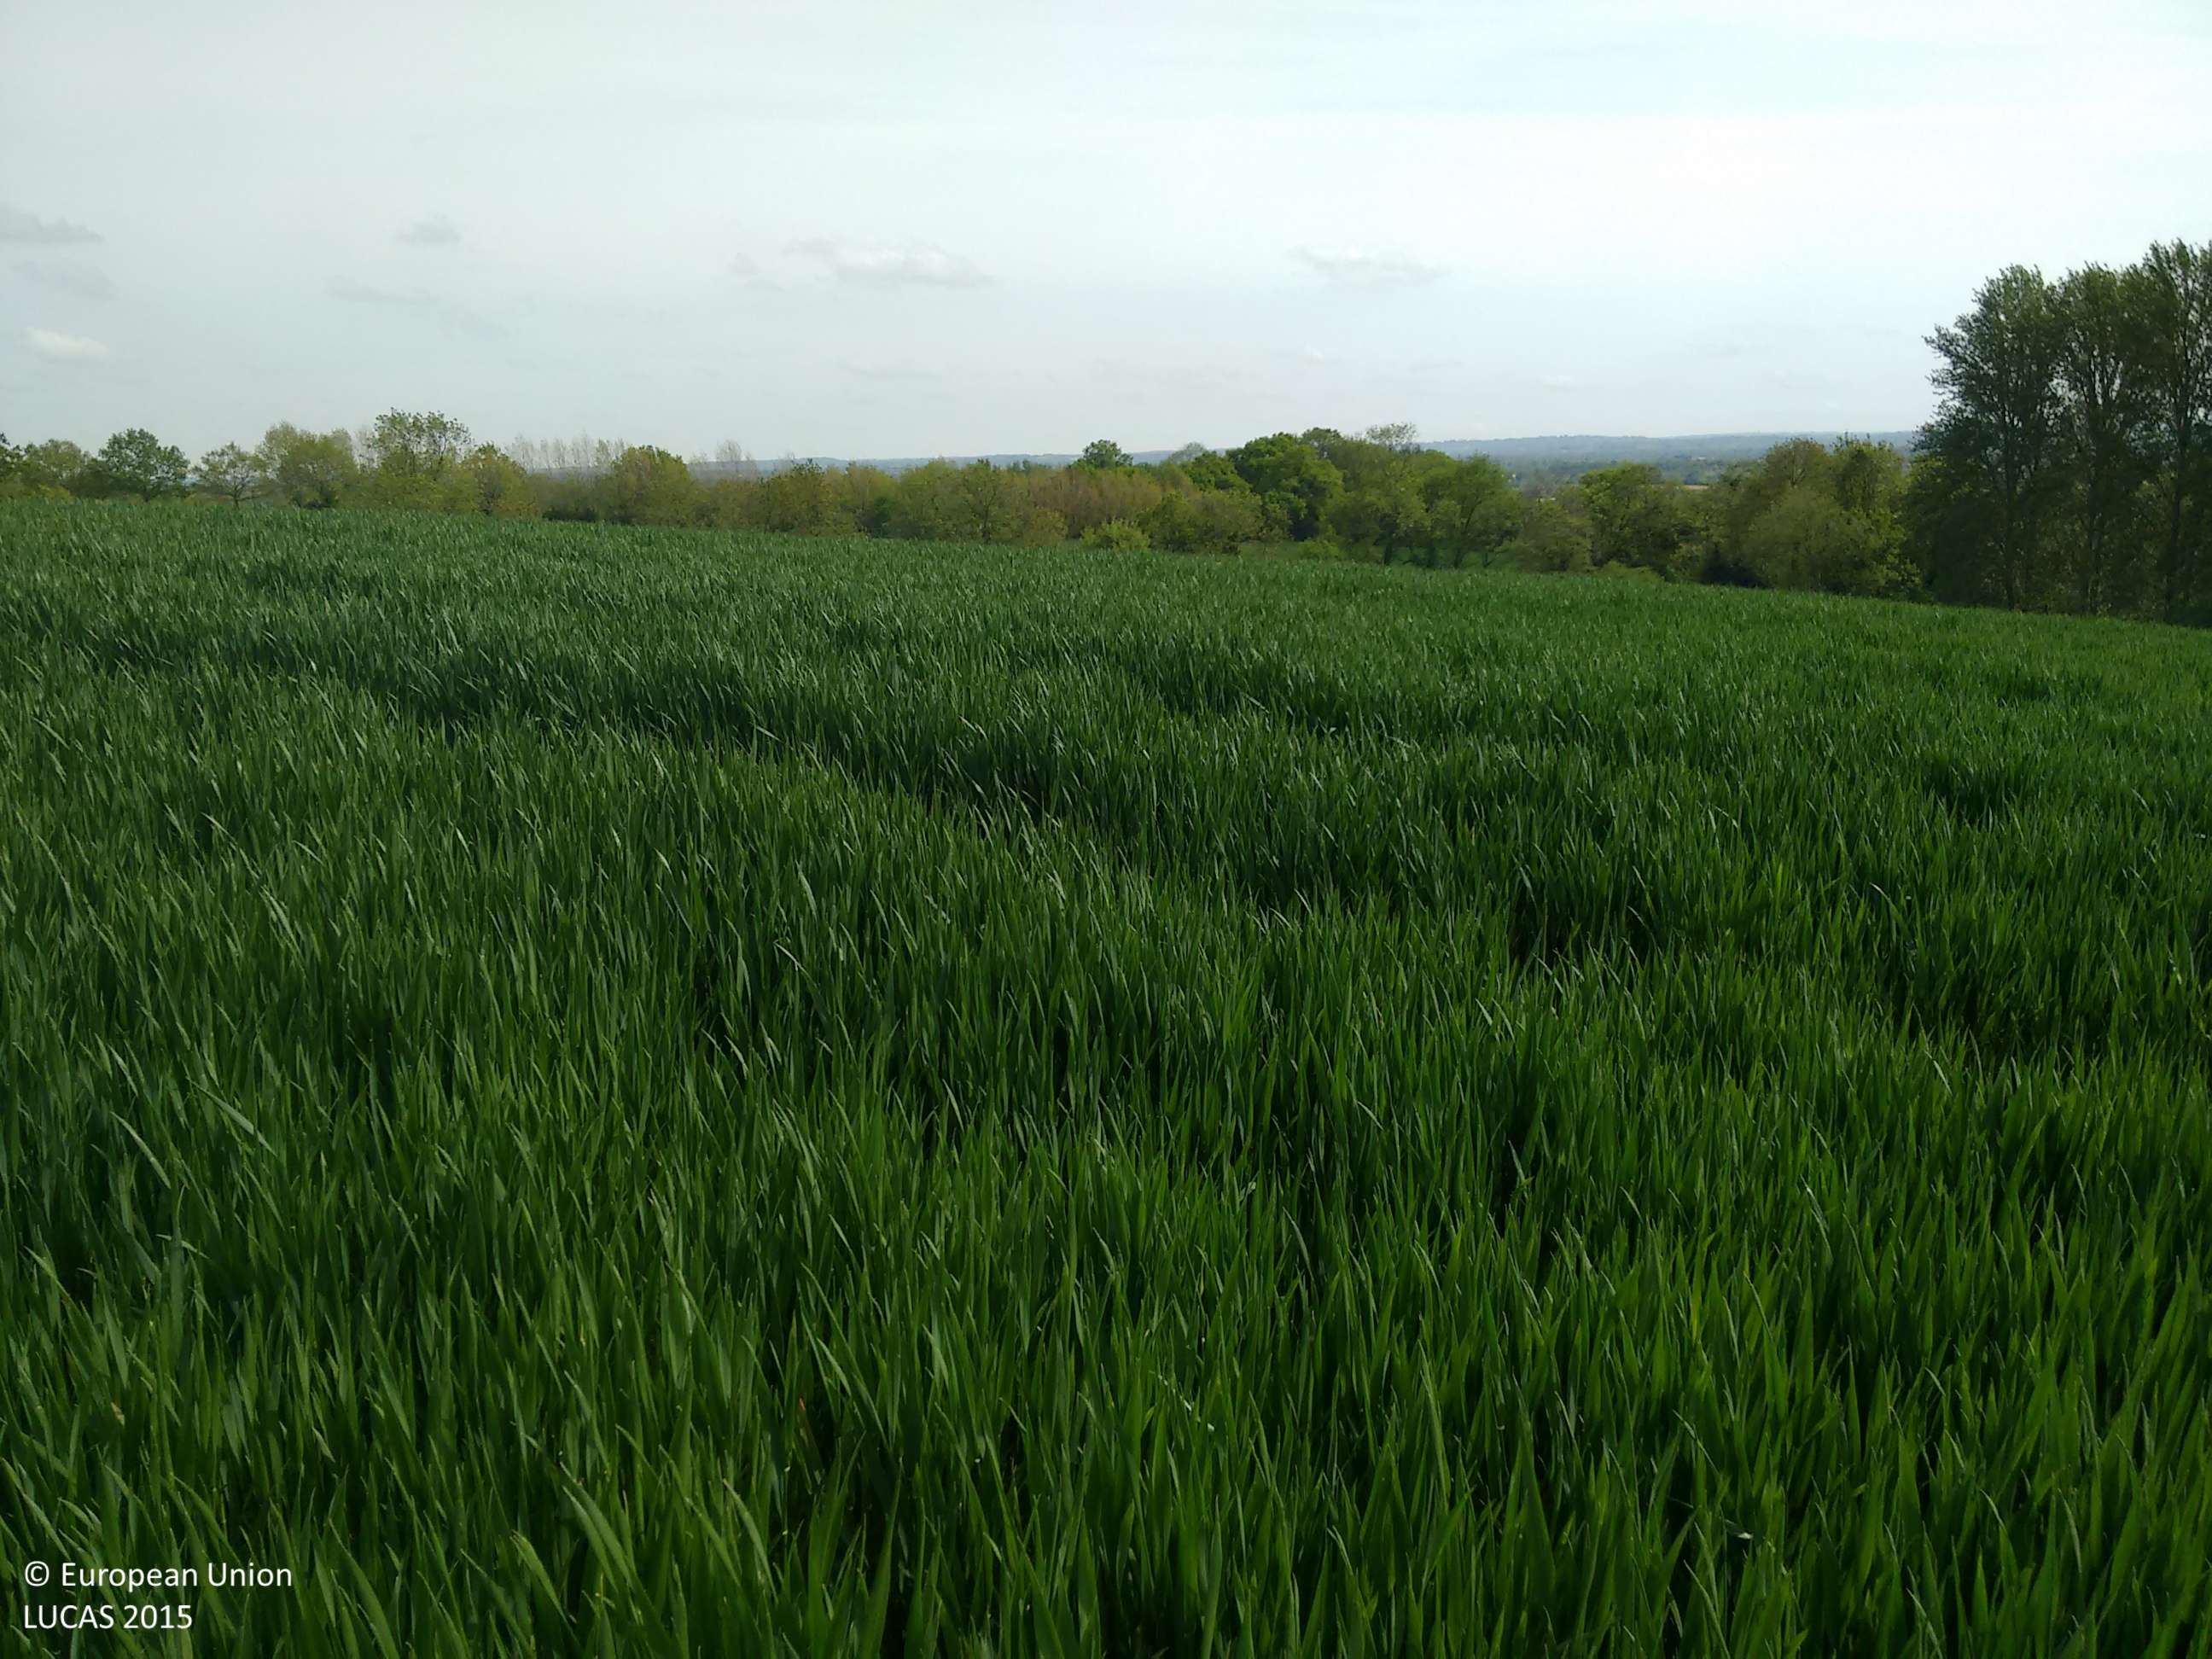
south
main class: Cropland
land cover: Barley
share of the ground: > 75 %
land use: Agriculture (excluding fallow land and kitchen gardens)
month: May
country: GB
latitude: 51.2310
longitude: 0.4481
